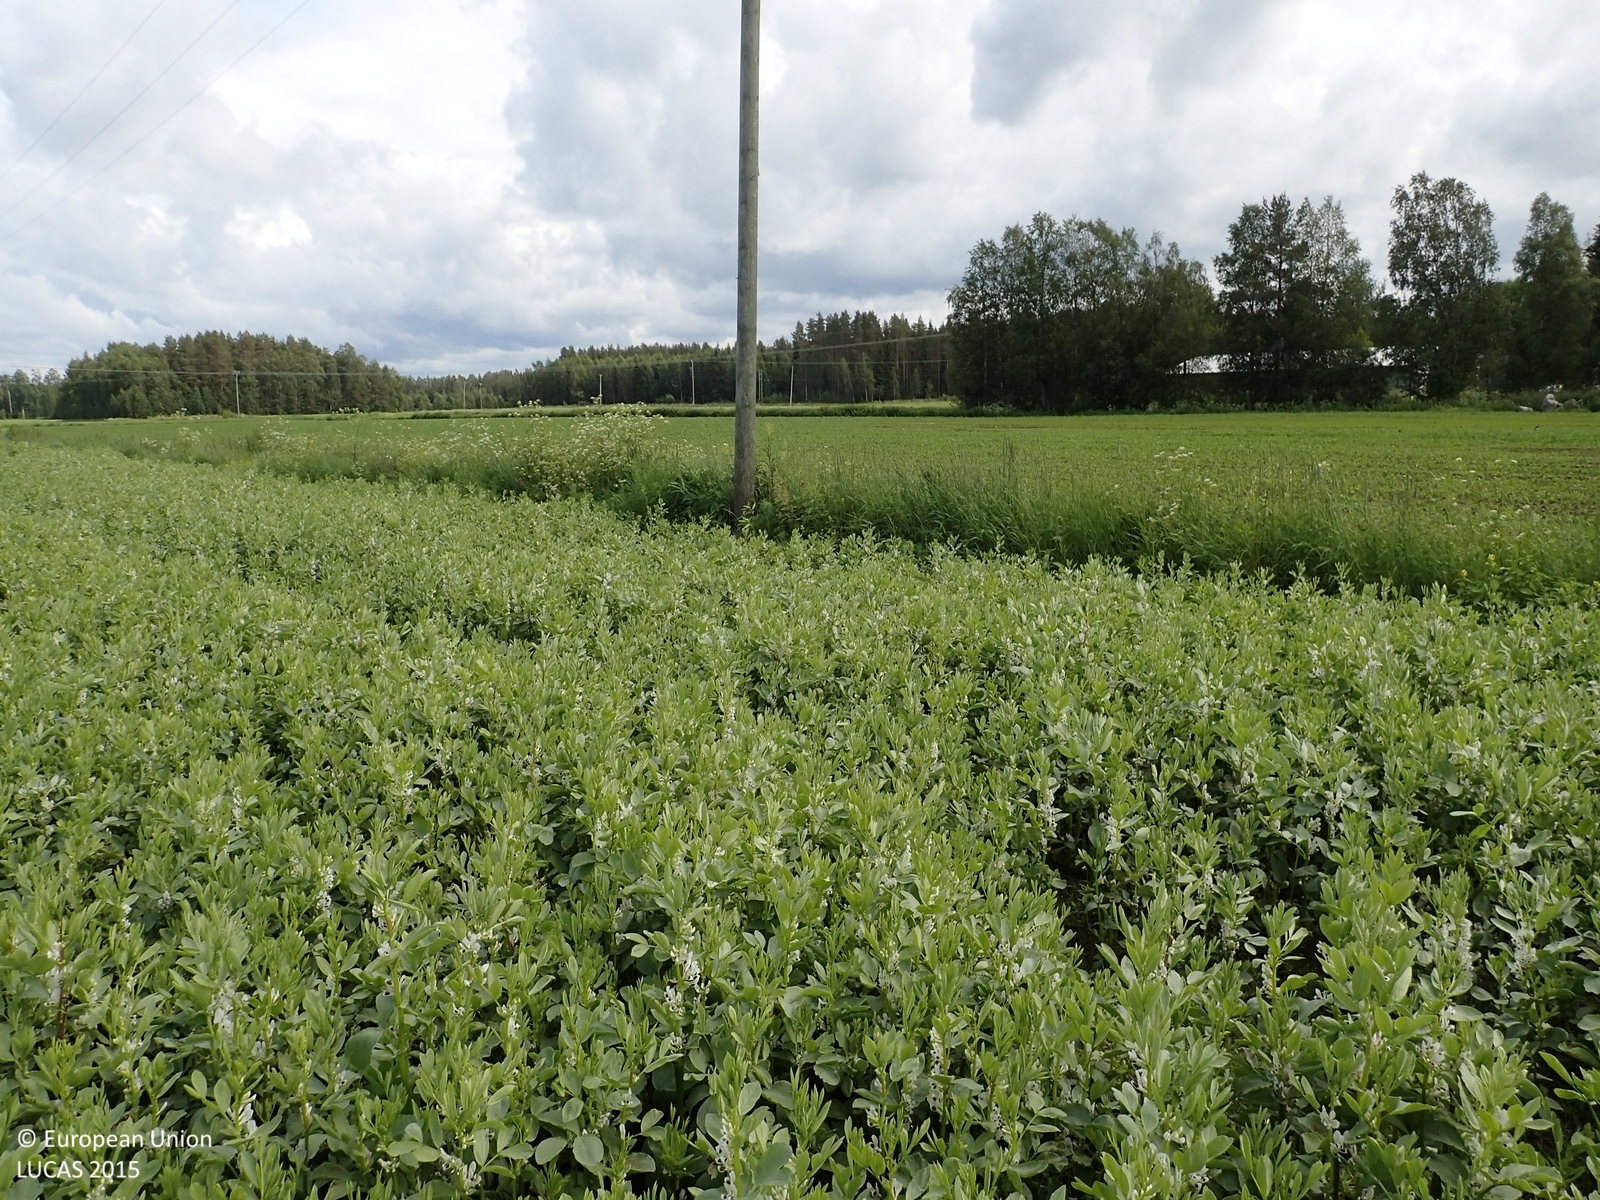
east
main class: Cropland
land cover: Dry pulses
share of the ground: > 75 %
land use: Agriculture (excluding fallow land and kitchen gardens)
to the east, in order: Dry pulses; Electric lines; Grass margins; Ditches and canals; Grass margins; Arable land (only in case pi)
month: July
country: FI
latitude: 62.9382
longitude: 21.4868
